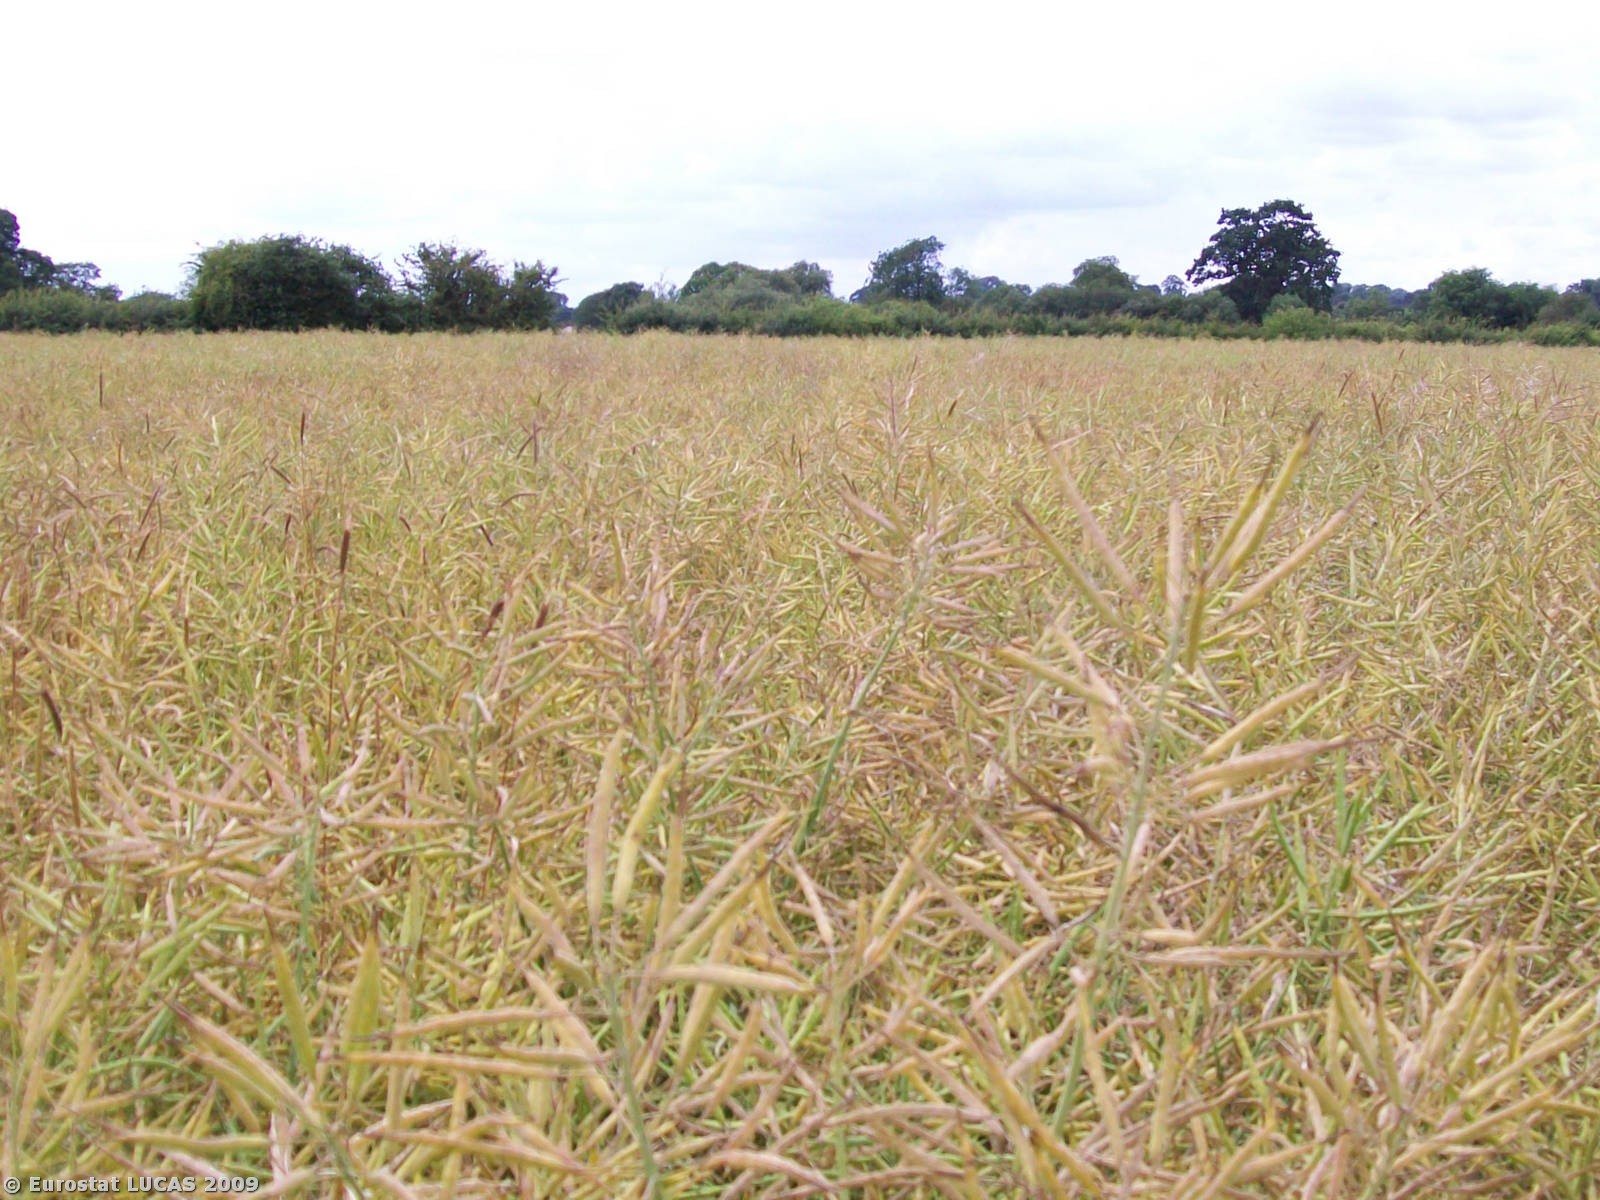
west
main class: Cropland
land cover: Rape and turnip rape
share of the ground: > 75 %
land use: Agriculture (excluding fallow land and kitchen gardens)
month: July
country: GB
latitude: 52.6068
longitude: -1.4051
